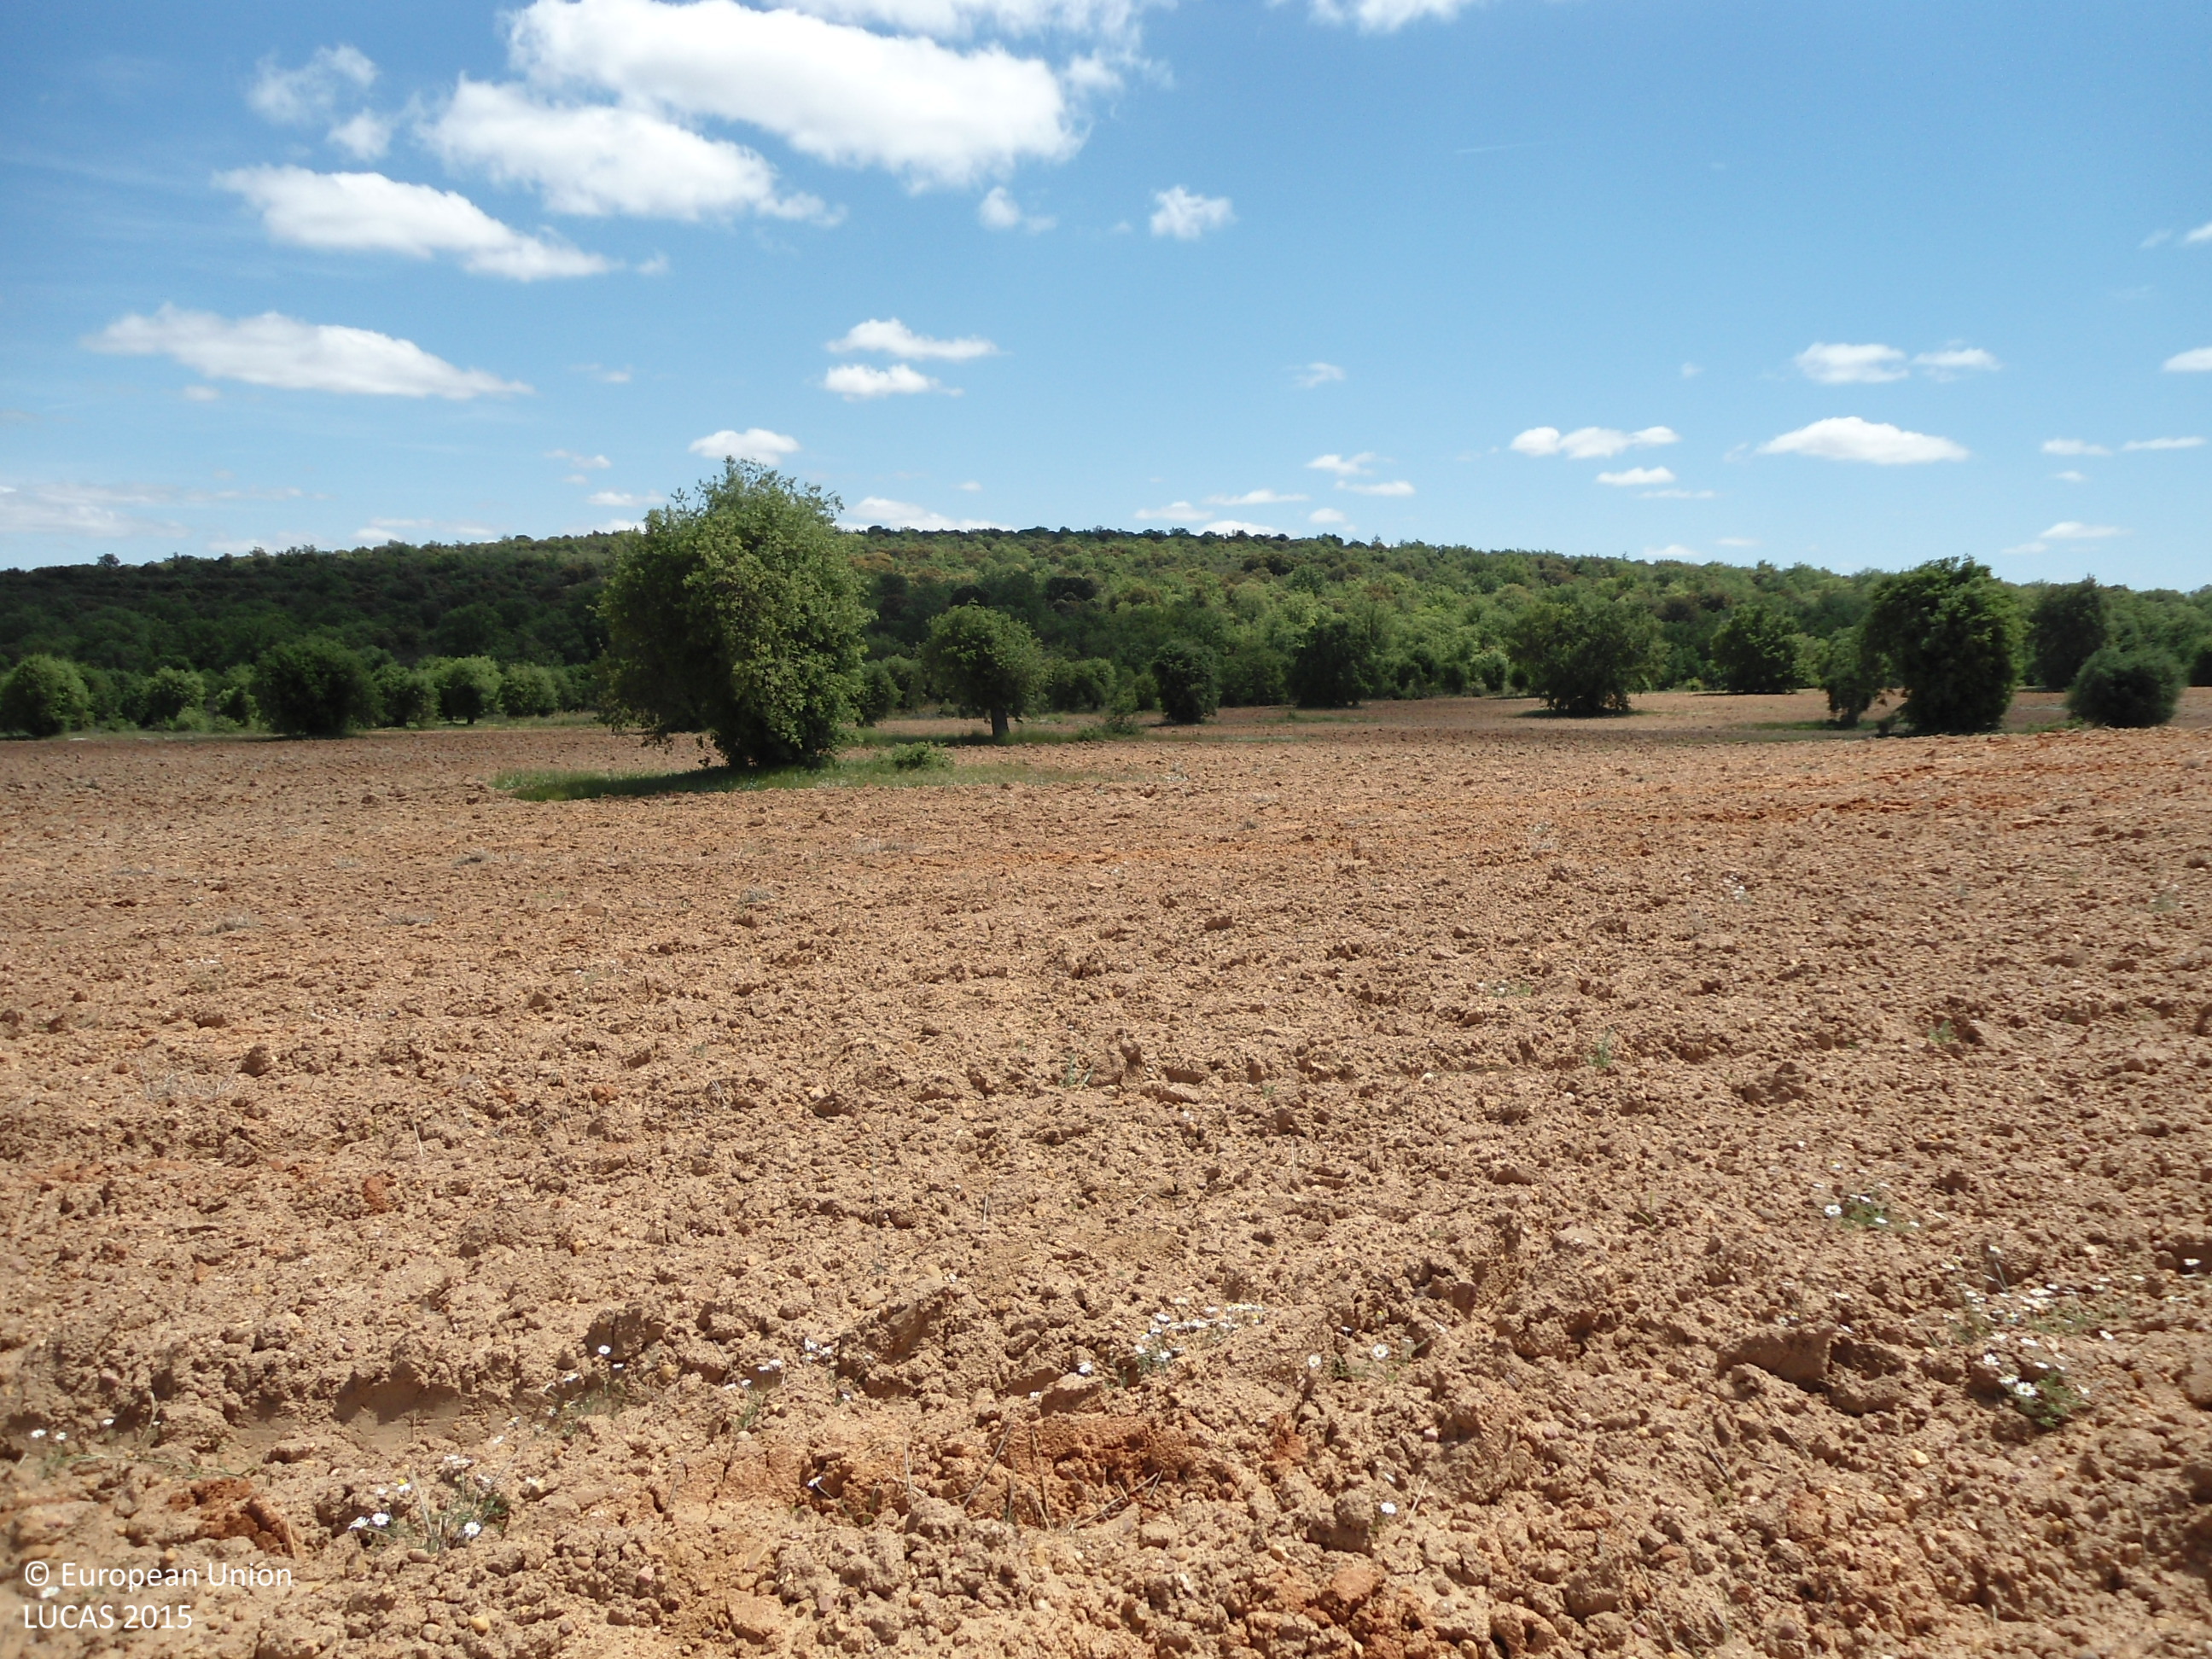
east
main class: Woodland
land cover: Broadleaved woodland
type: broadleaved evergreen forest
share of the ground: 25 - 50 %
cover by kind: unconsolidated bare surface 70 %, broadleaved forest trees 30 %
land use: Forestry
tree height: > 5 m
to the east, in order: Broadleaved woodland; Other bare soil; Shrubland with sparse tree cover; Broadleaved woodland
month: May
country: ES
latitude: 41.8857
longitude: -5.8940
